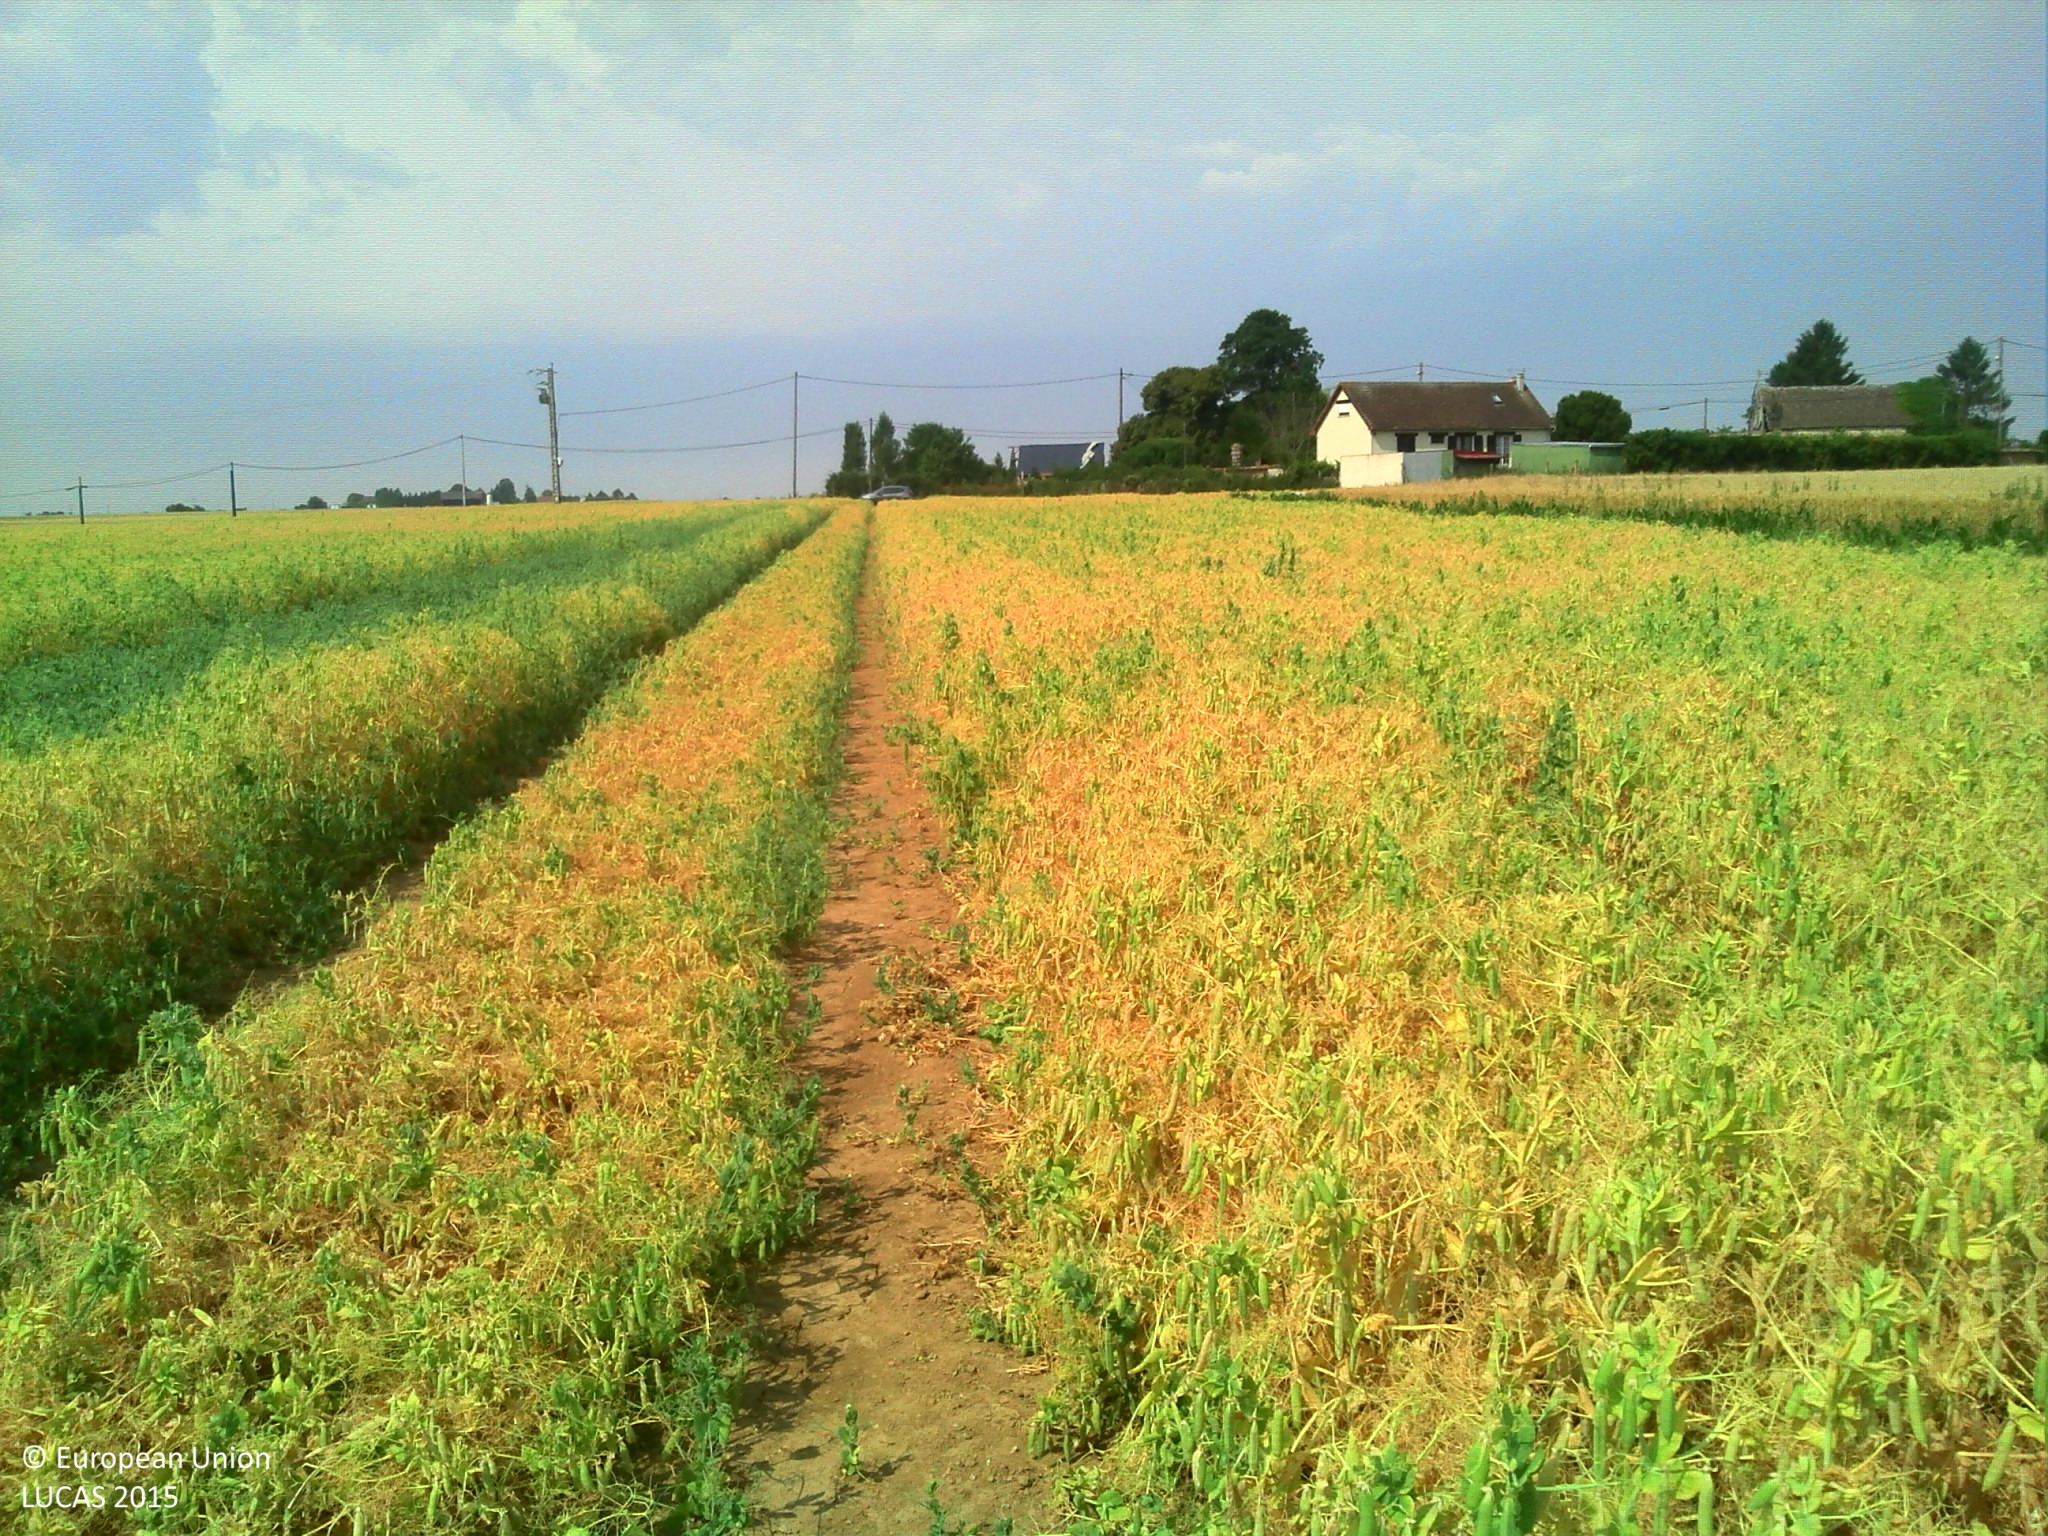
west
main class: Cropland
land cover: Dry pulses
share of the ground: > 75 %
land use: Agriculture (excluding fallow land and kitchen gardens)
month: July
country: FR
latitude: 48.8876
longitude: 1.2384
